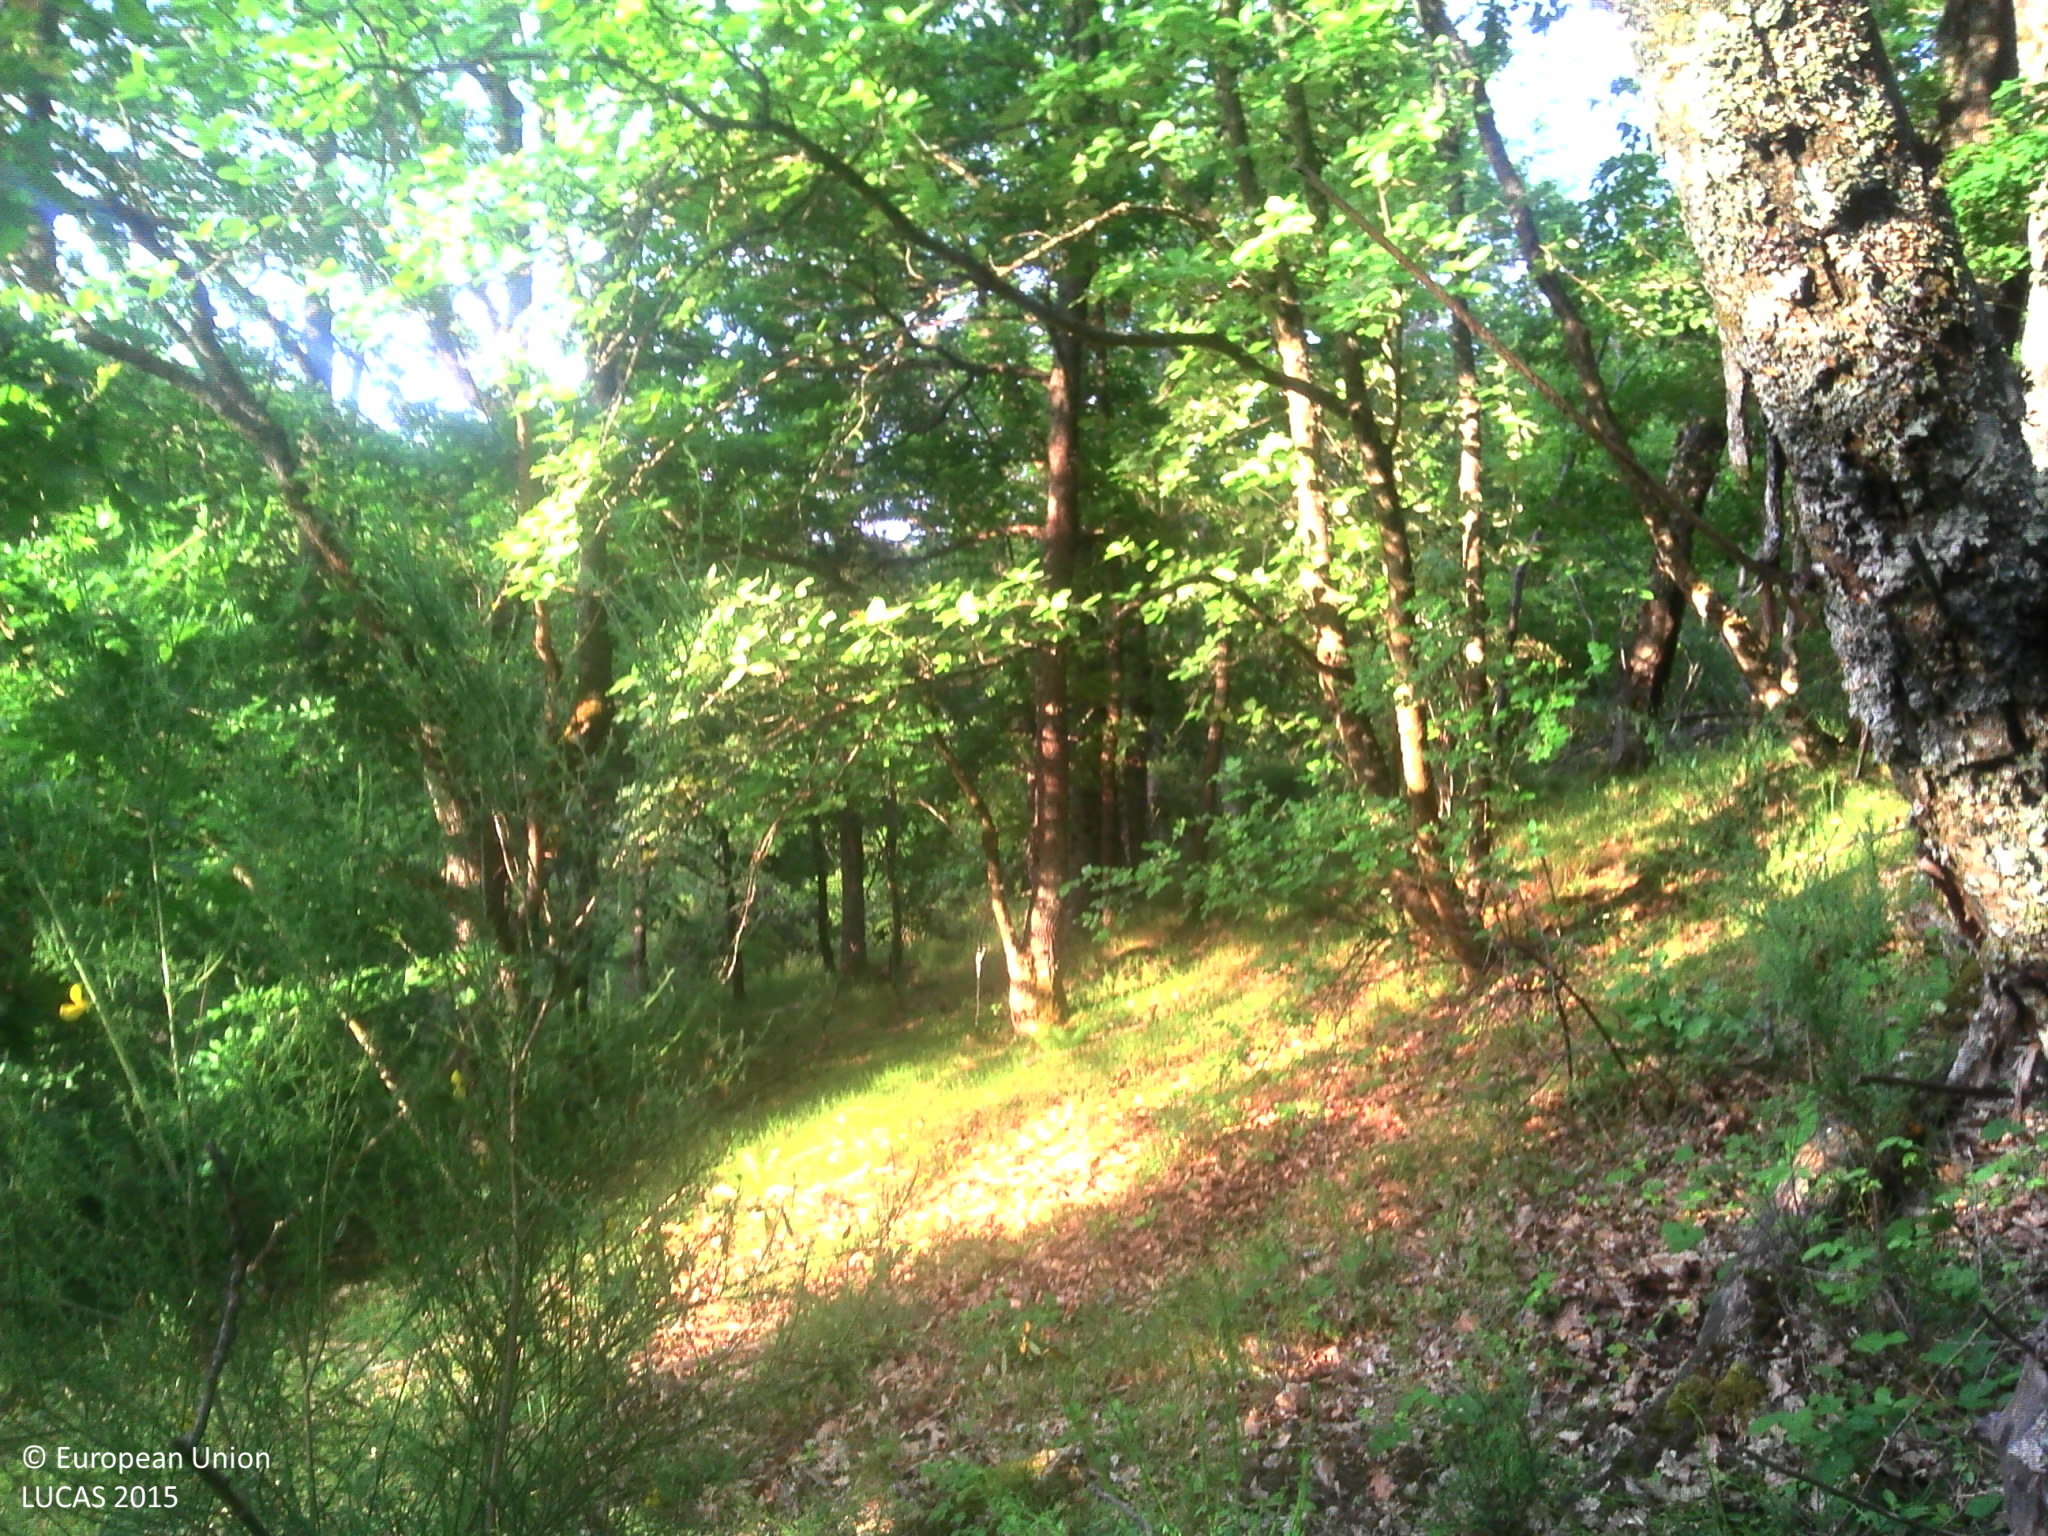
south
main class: Woodland
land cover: Broadleaved woodland
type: mesophytic deciduous forest
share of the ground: > 75 %
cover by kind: broadleaved forest trees 70 %, herbaceous plants 20 %, shrubs 10 %
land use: Forestry
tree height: > 5 m
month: June
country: FR
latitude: 45.1941
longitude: 3.1920
